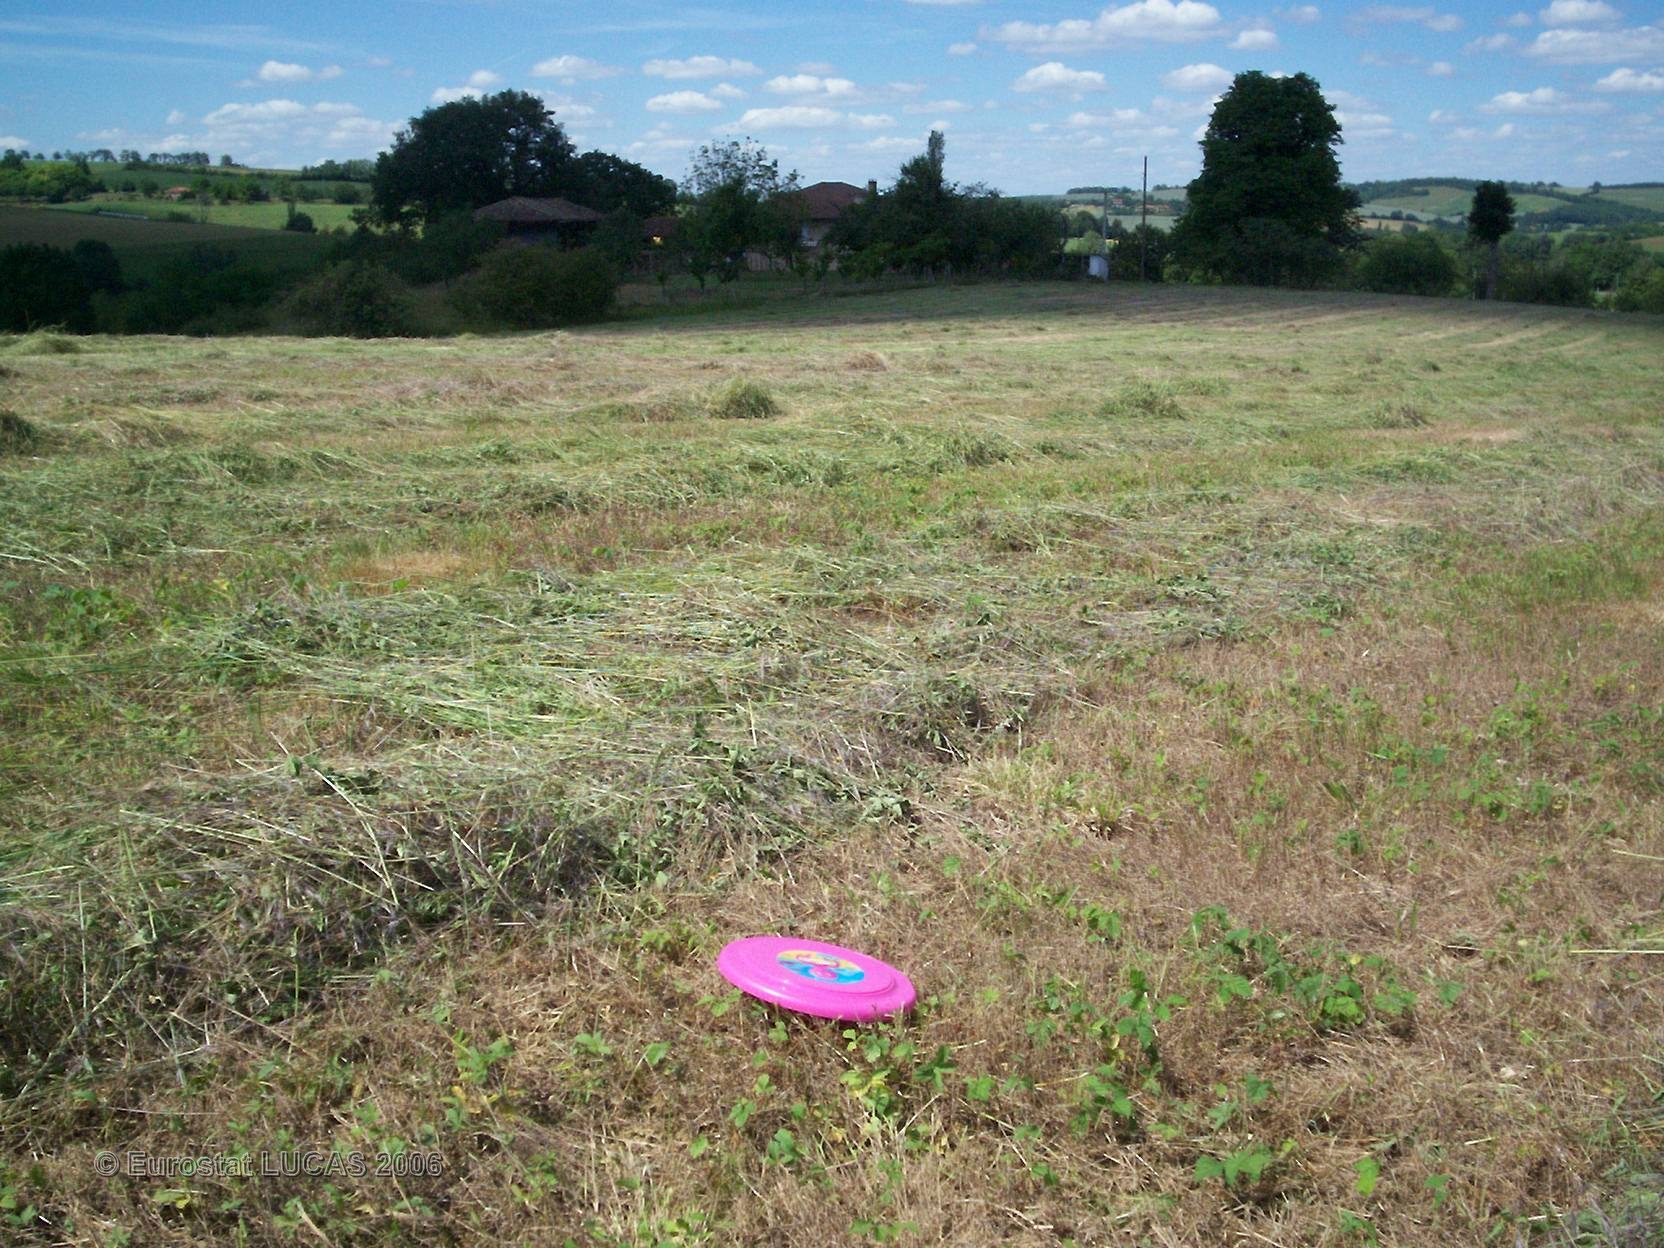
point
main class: Grassland
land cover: Grassland without tree/shrub cover
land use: Agriculture (excluding fallow land and kitchen gardens)
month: May
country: FR
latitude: 43.4144
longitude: 0.9983
